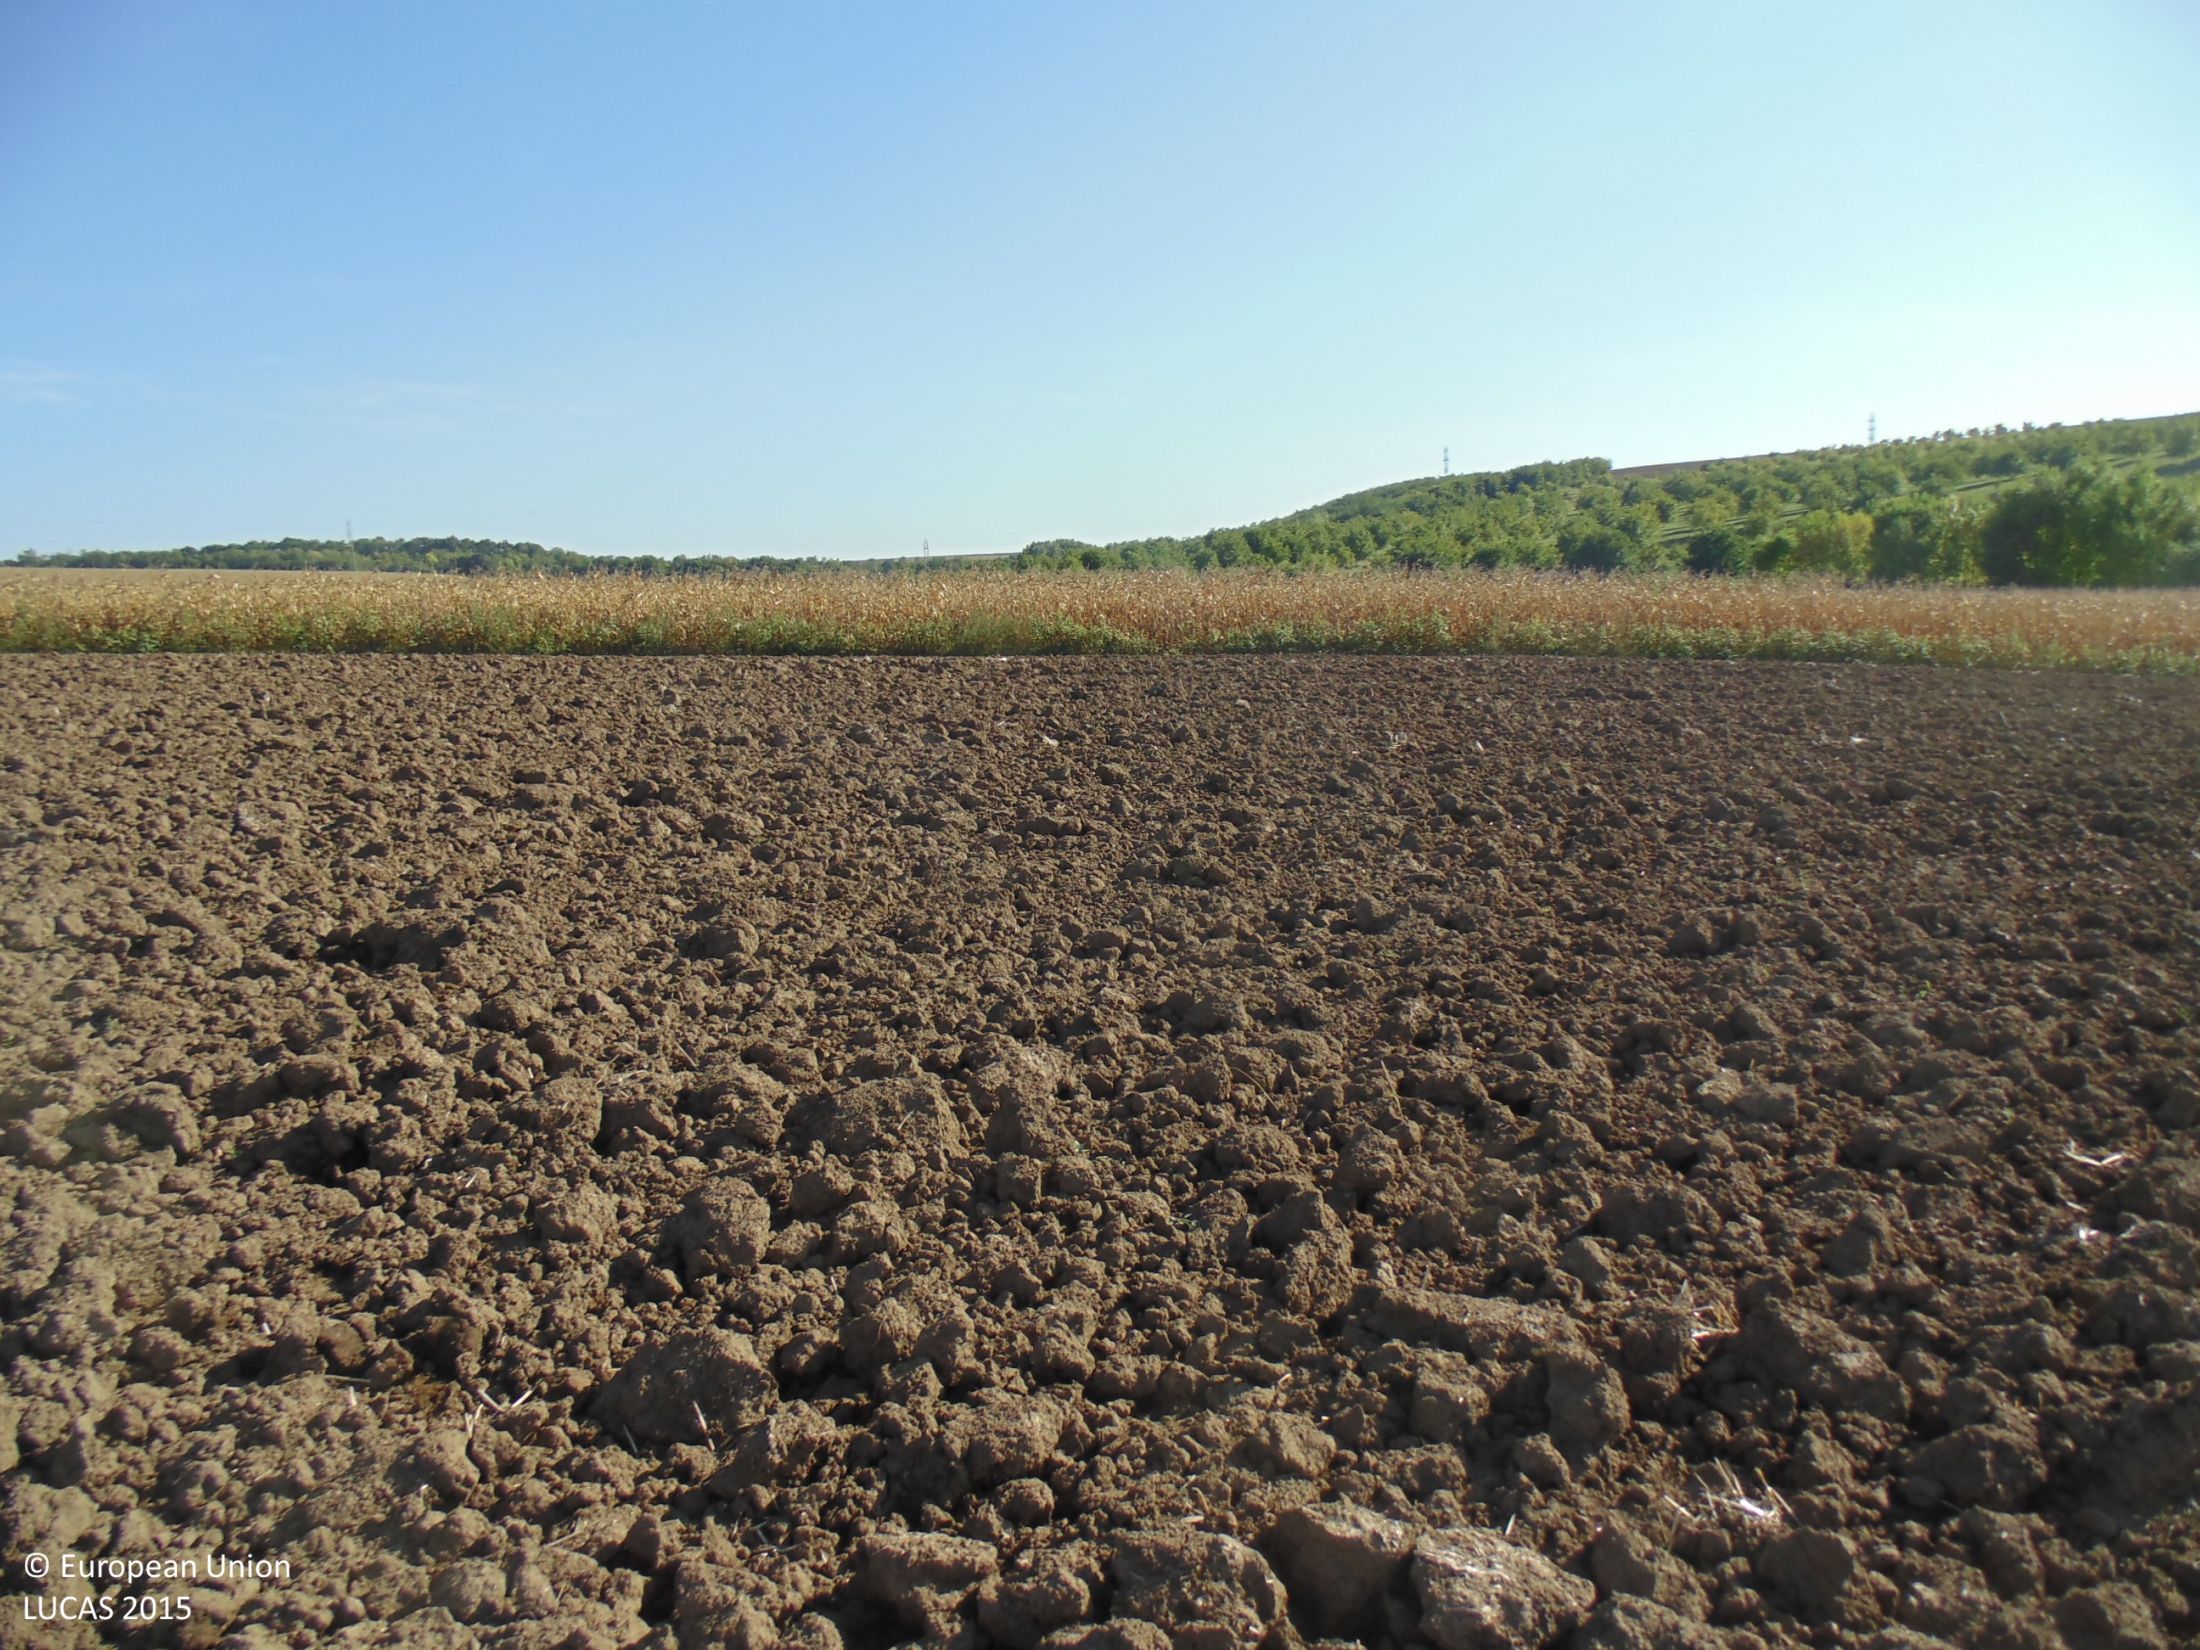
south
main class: Cropland
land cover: Common wheat
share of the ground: < 10 %
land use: Agriculture (excluding fallow land and kitchen gardens)
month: September
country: BG
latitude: 44.0461
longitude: 26.9590
